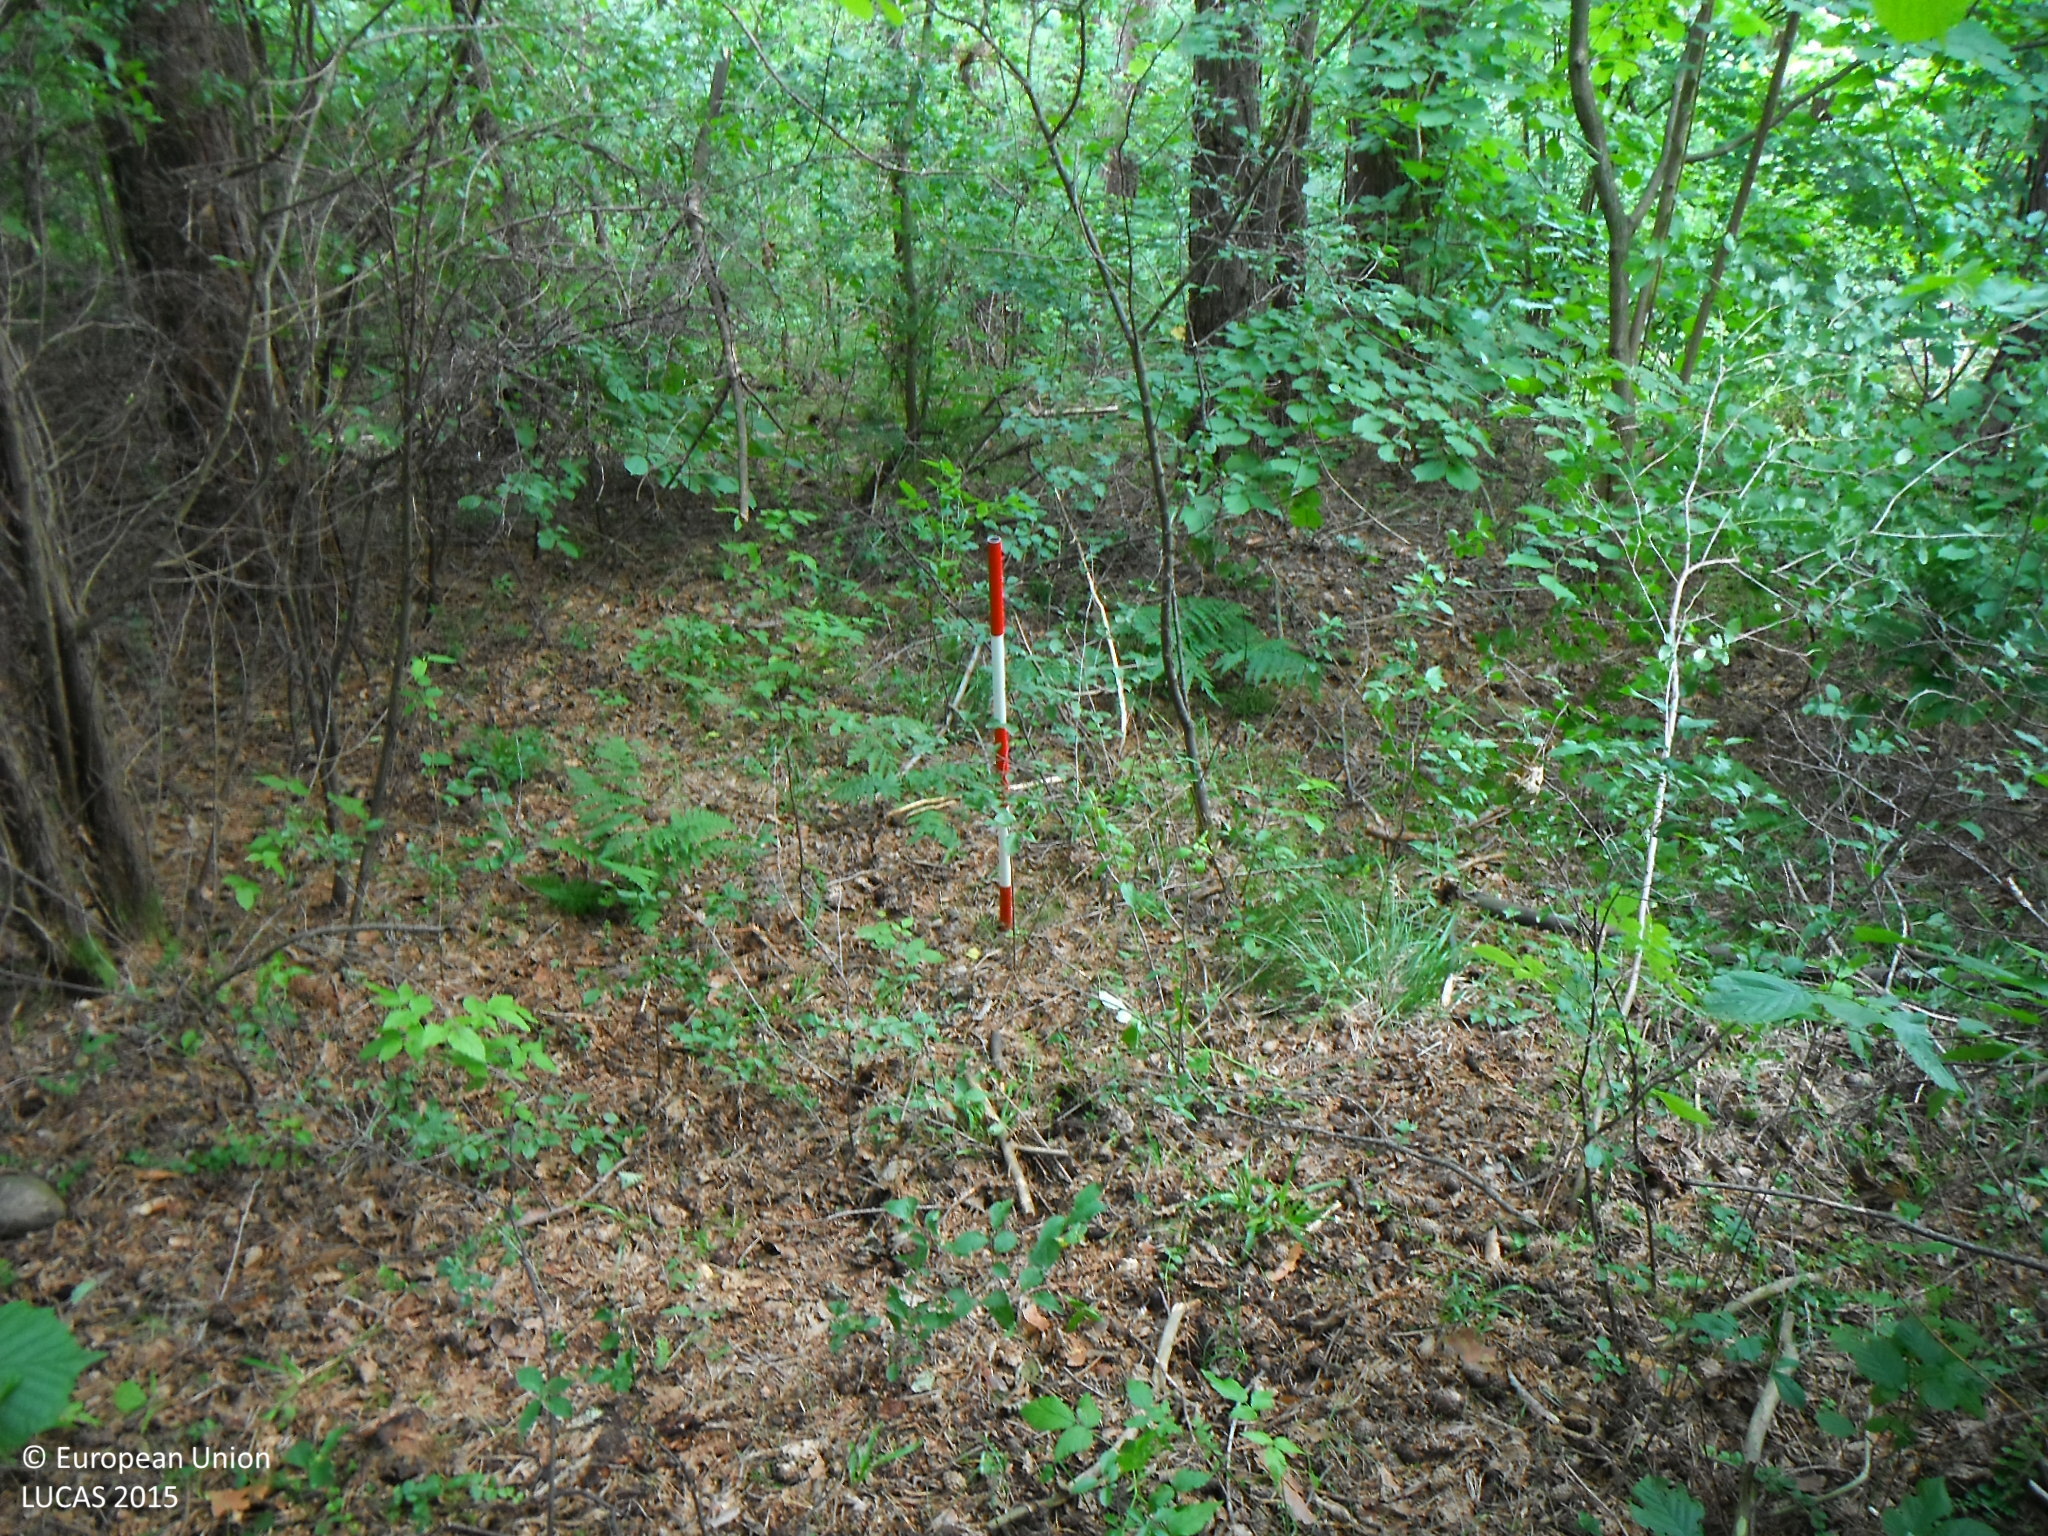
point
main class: Woodland
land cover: Pine dominated mixed woodland
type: hemiboreal forest and nemoral coniferous forest and mixed broadleaved-coniferous forest
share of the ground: > 75 %
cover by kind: coniferous forest trees 60 %, broadleaved forest trees 30 %, shrubs 10 %
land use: Forestry
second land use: Amenities, museums, leisure
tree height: > 5 m
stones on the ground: < 10 %
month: June
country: SK
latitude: 48.9675
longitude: 20.9280
